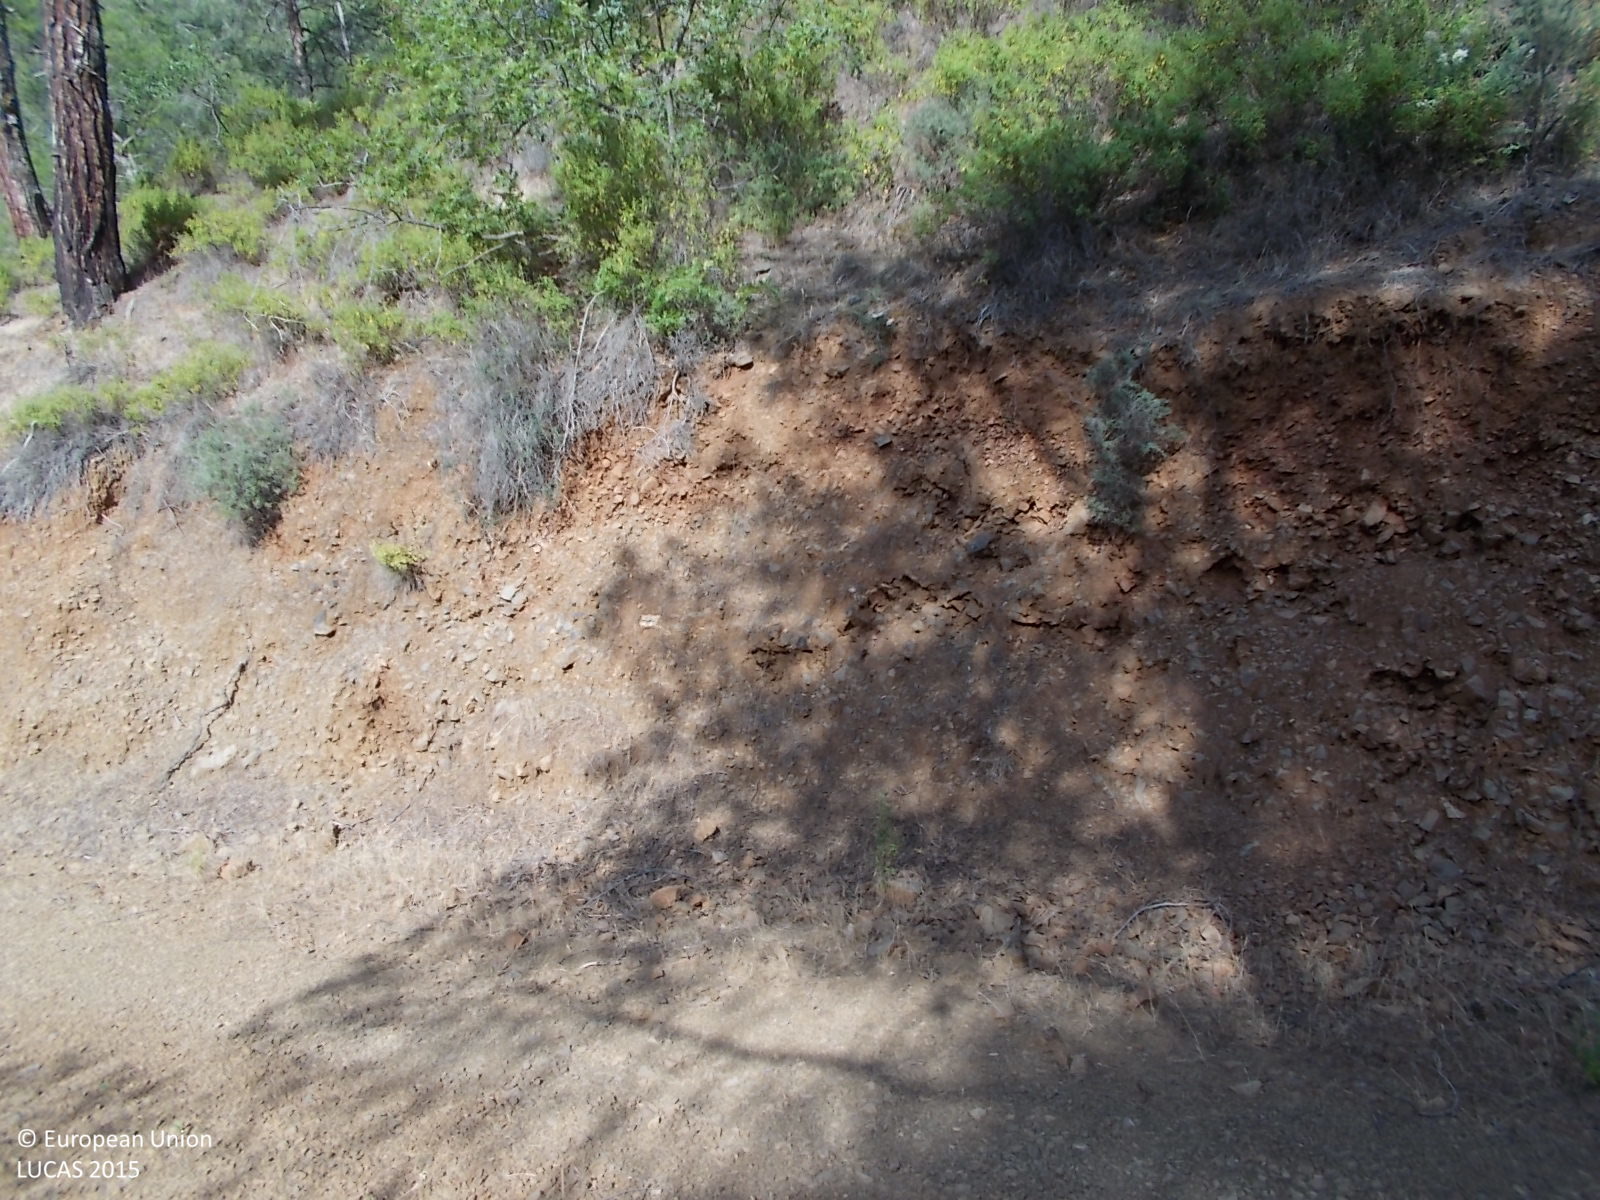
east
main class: Woodland
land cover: Pine dominated mixed woodland
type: coniferous forest of the mediterranean region
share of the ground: > 75 %
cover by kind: coniferous forest trees 50 %, broadleaved forest trees 25 %, unconsolidated bare surface 15 %, shrubs 10 %
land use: Forestry
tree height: > 5 m
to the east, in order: Pine dominated mixed woodland; Rivers and streams; Pine dominated coniferous woodland; Paved roads, cycling and walking lanes; Pine dominated coniferous woodland; Rivers and streams
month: June
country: CY
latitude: 35.1437
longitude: 32.6552
